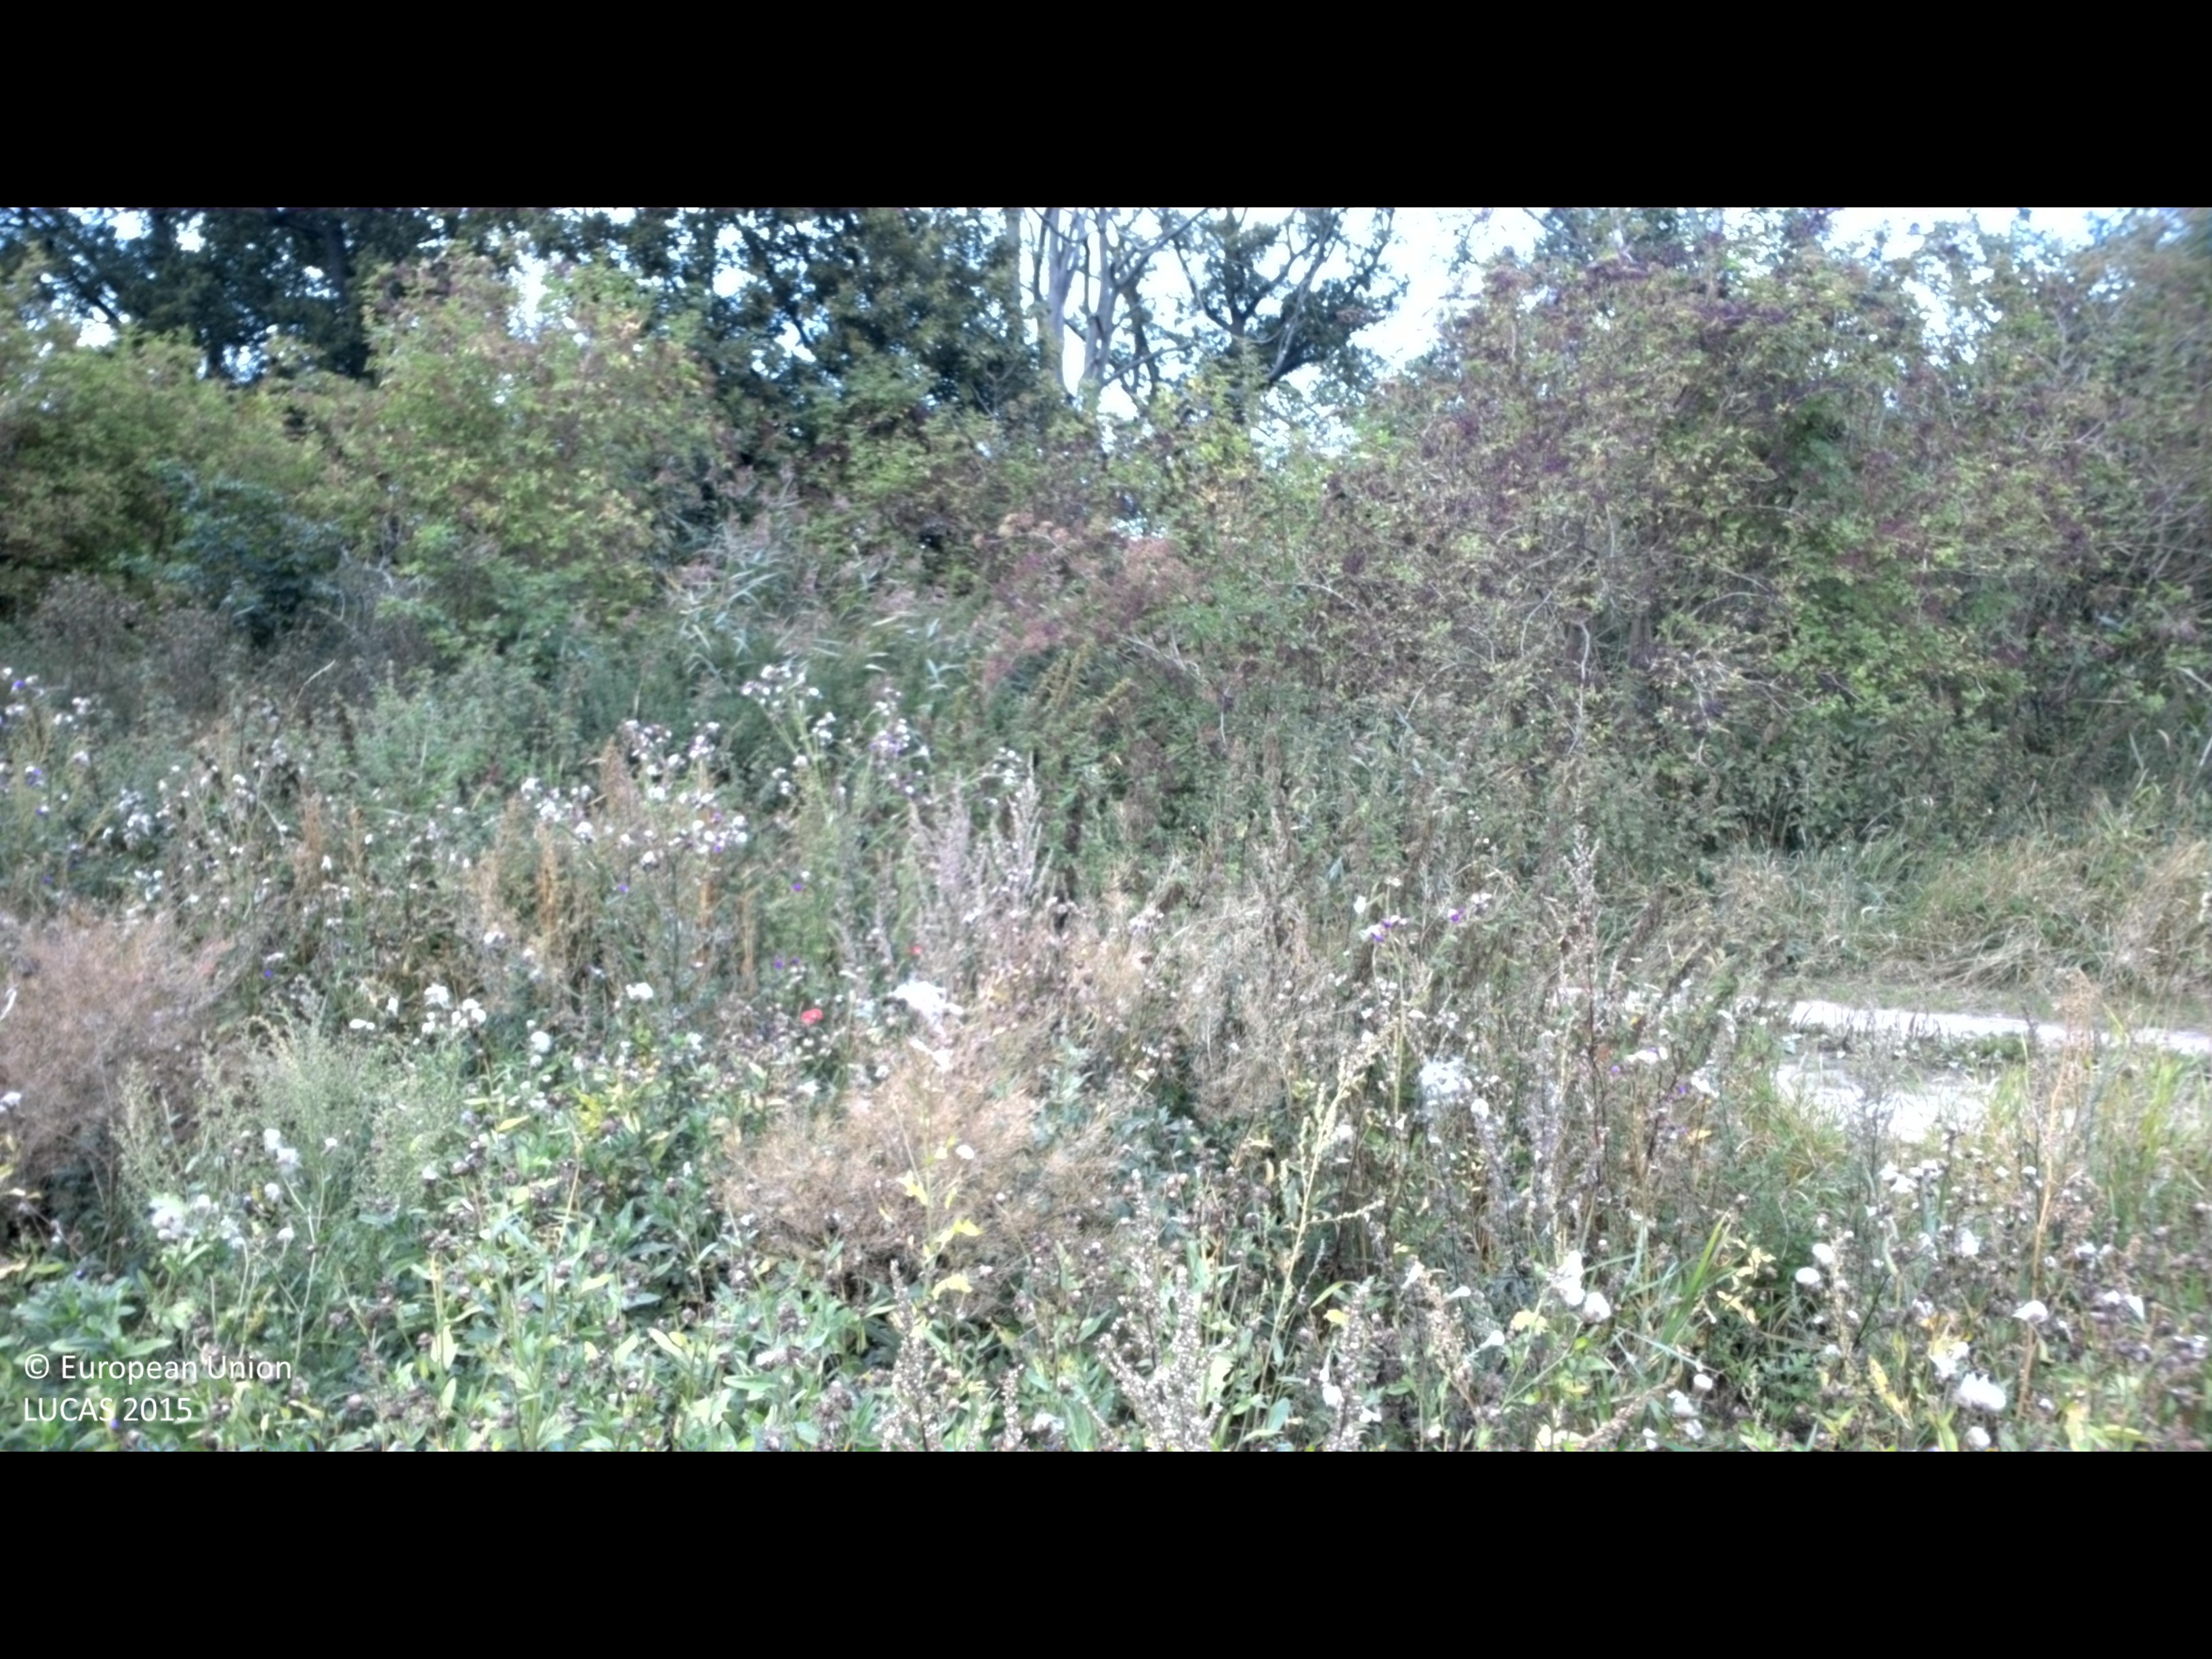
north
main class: Cropland
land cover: Sugar beet
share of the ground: > 75 %
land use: Agriculture (excluding fallow land and kitchen gardens)
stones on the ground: < 10 %
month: September
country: SE
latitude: 56.0780
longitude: 14.3522
